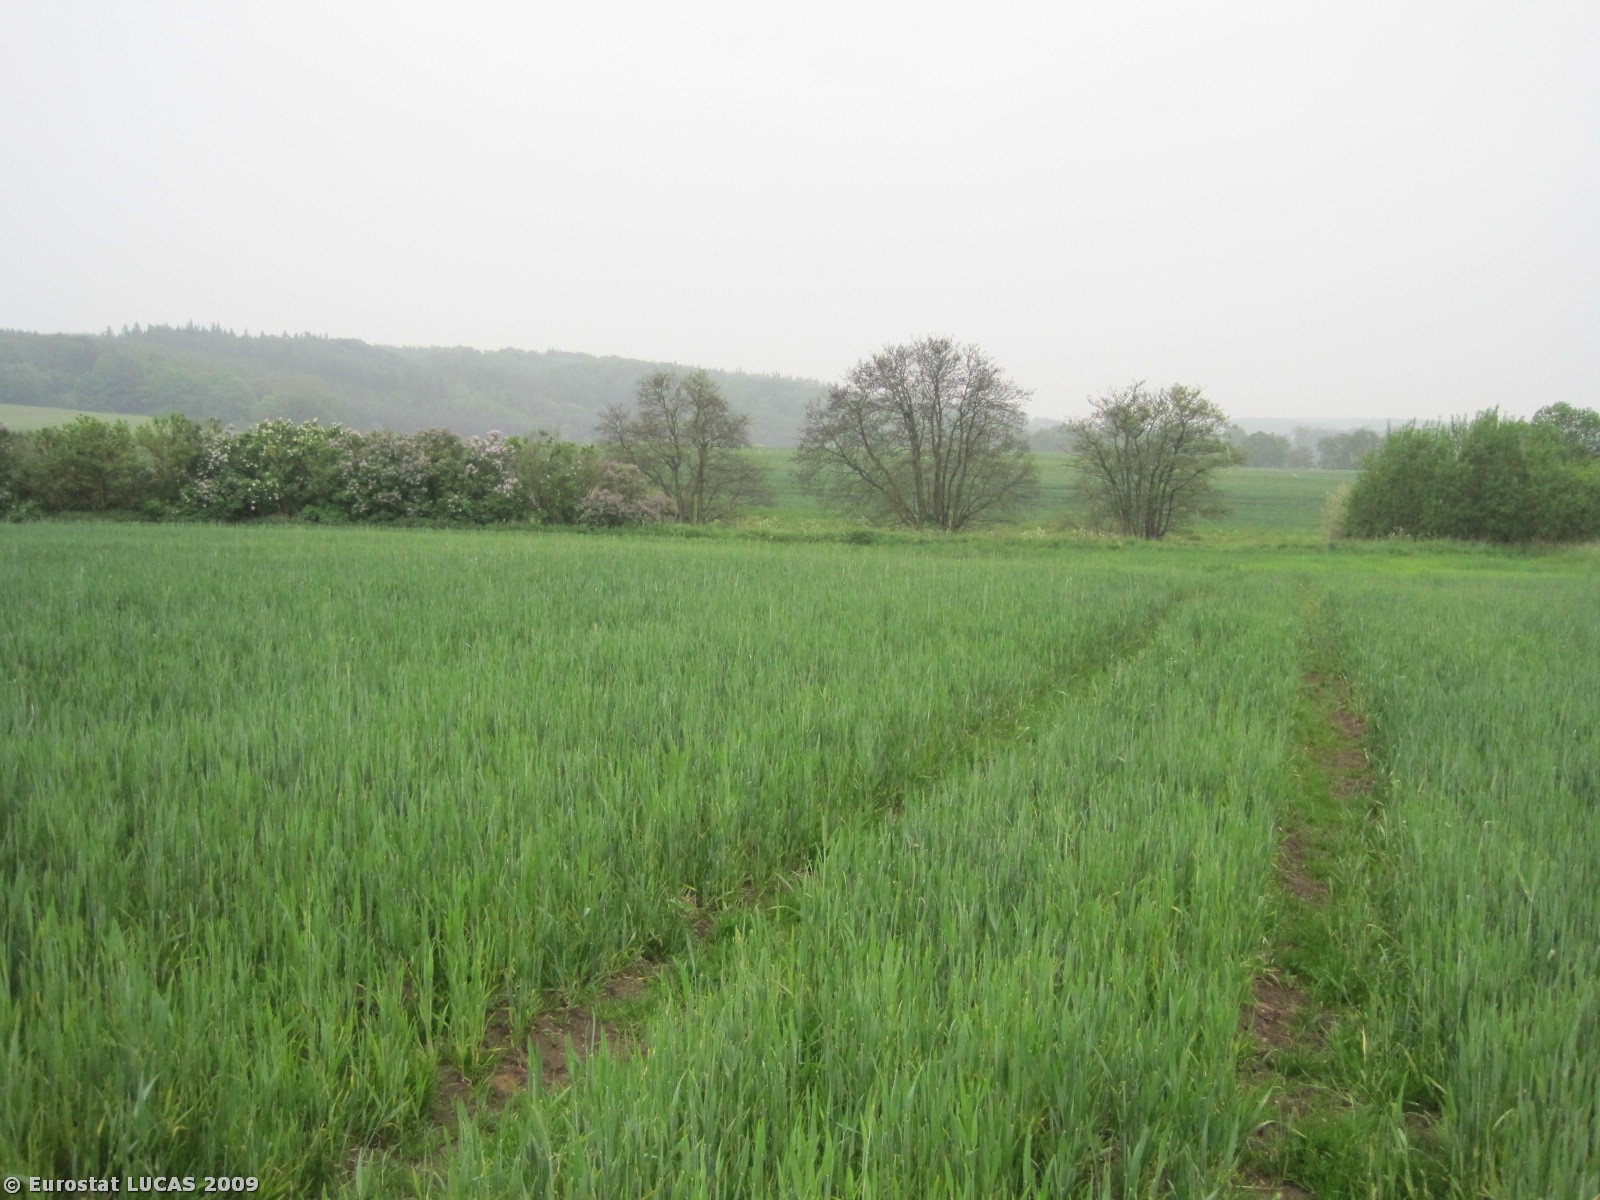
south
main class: Cropland
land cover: Common wheat
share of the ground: > 75 %
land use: Agriculture (excluding fallow land and kitchen gardens)
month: May
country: DK
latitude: 56.3315
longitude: 9.9192
